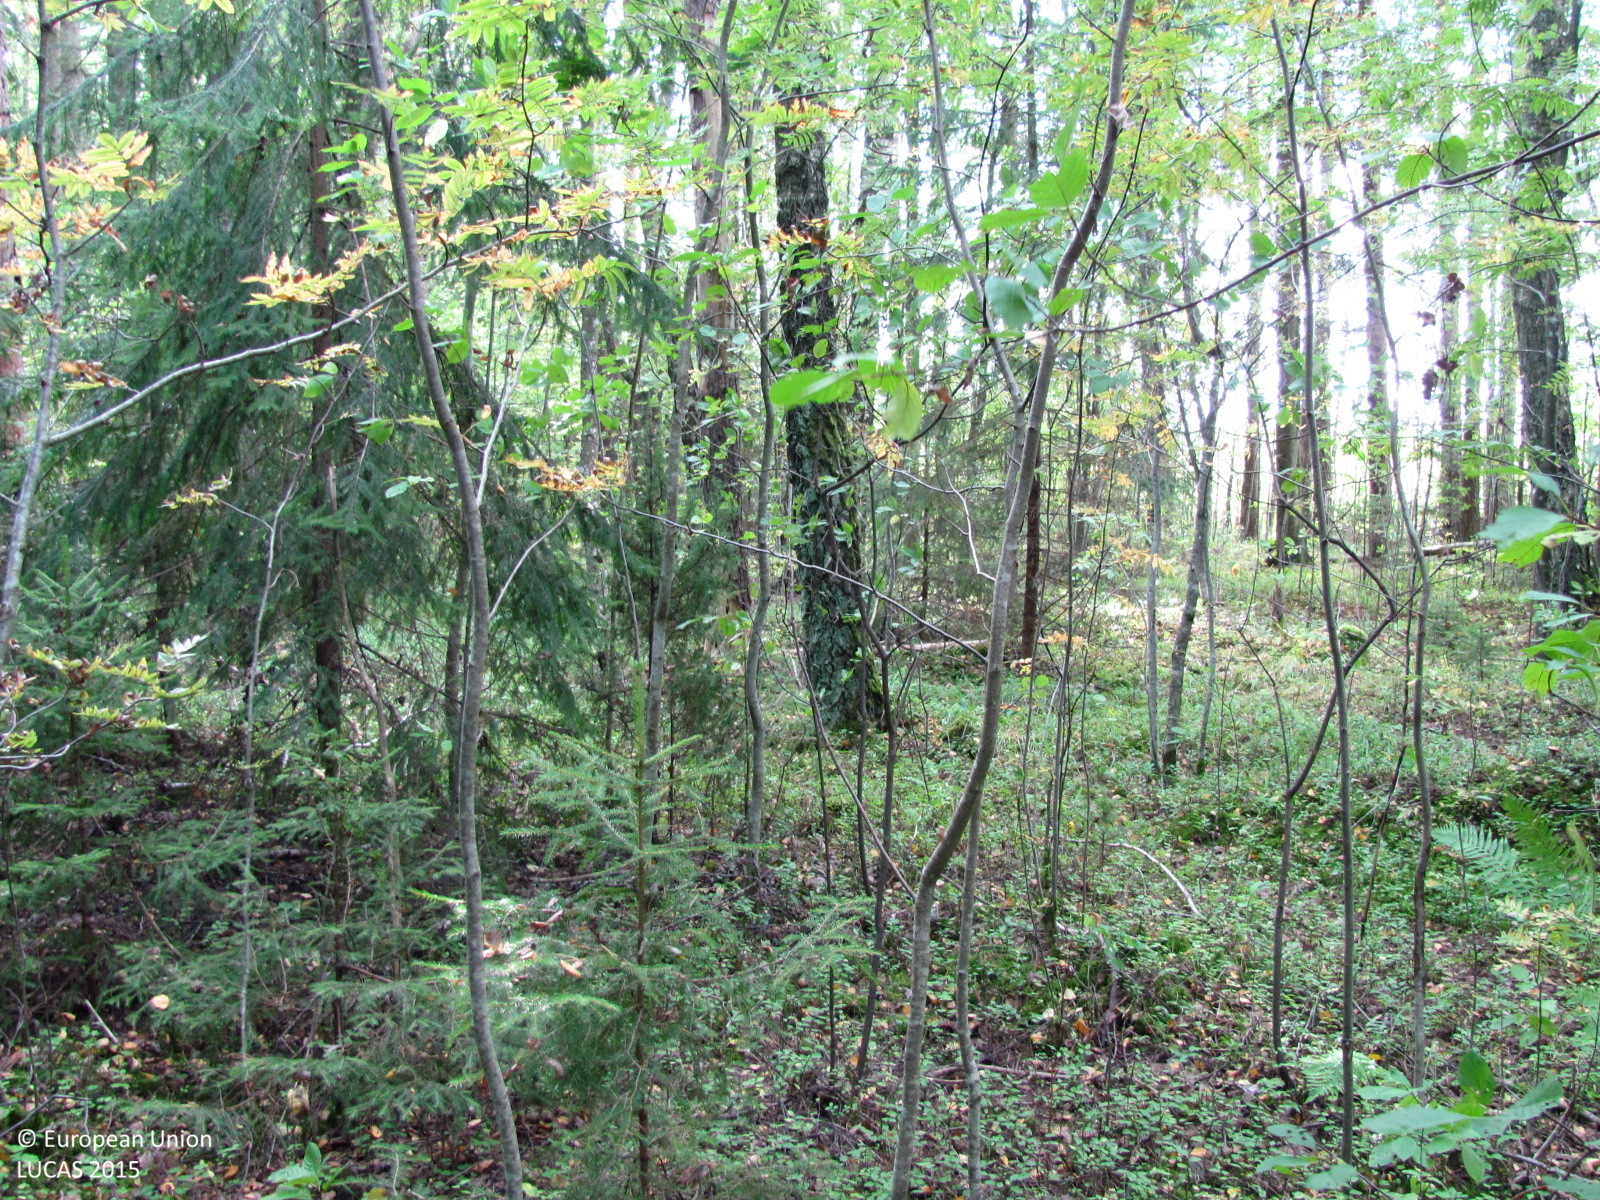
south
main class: Woodland
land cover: Other mixed woodland
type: hemiboreal forest and nemoral coniferous forest and mixed broadleaved-coniferous forest
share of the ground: > 75 %
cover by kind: coniferous forest trees 40 %, broadleaved forest trees 40 %, herbaceous plants 10 %, lichens and mosses 10 %
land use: Forestry
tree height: > 5 m
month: September
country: LV
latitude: 56.6615
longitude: 25.1027
